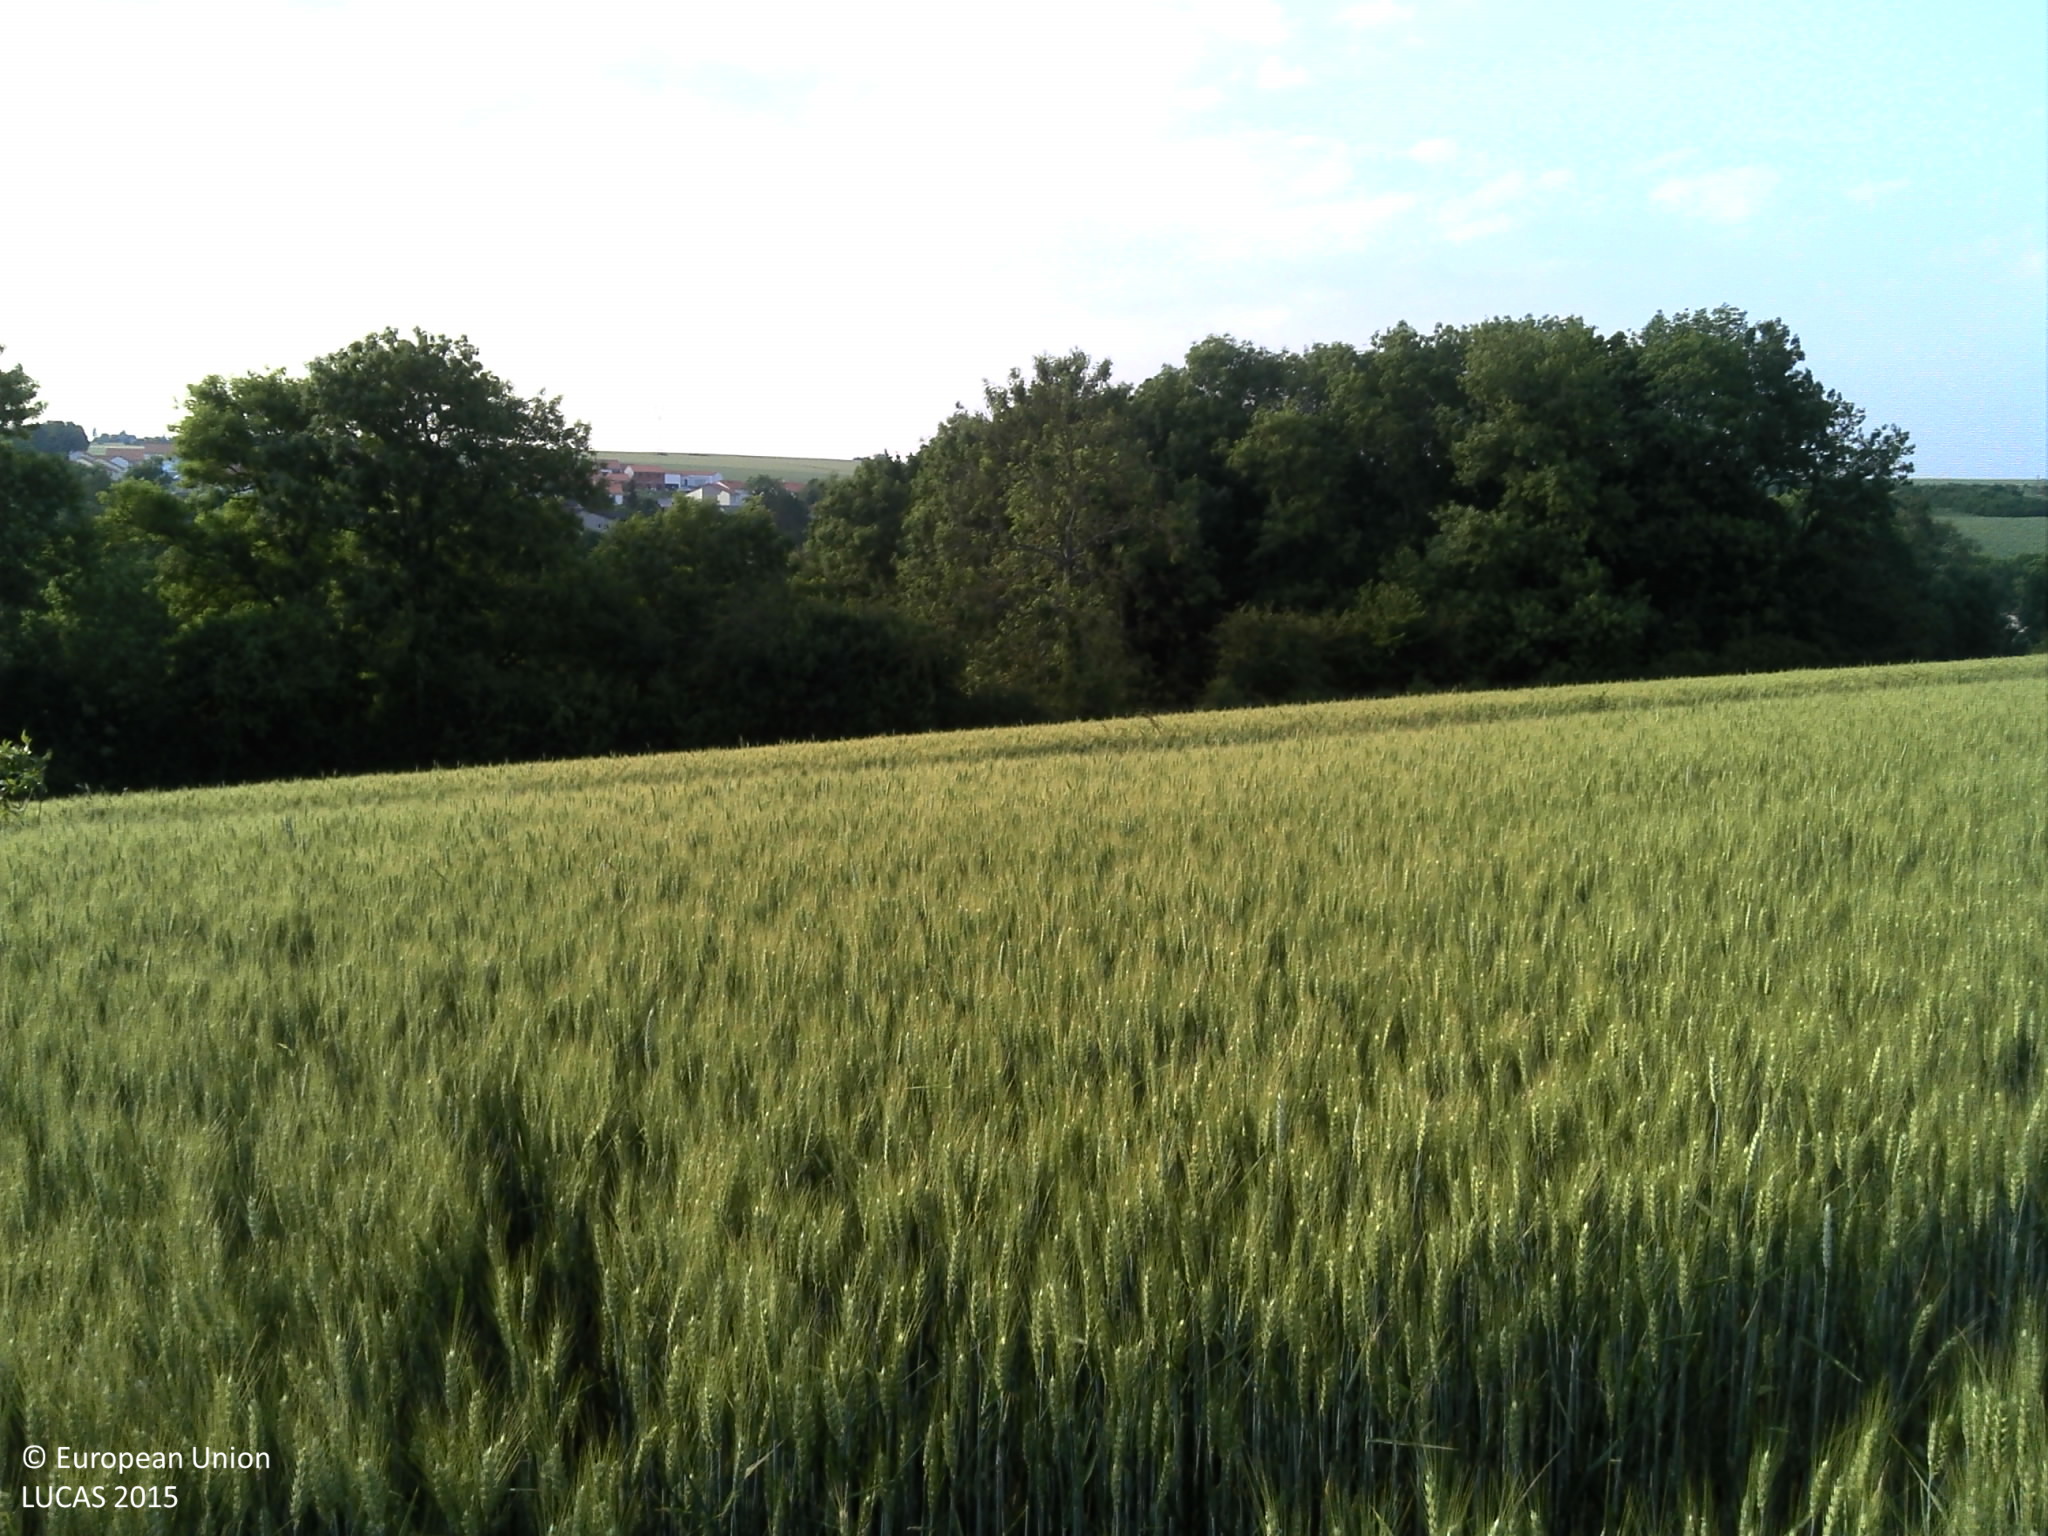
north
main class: Cropland
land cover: Common wheat
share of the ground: > 75 %
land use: Agriculture (excluding fallow land and kitchen gardens)
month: June
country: FR
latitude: 49.1326
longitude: 6.2582
